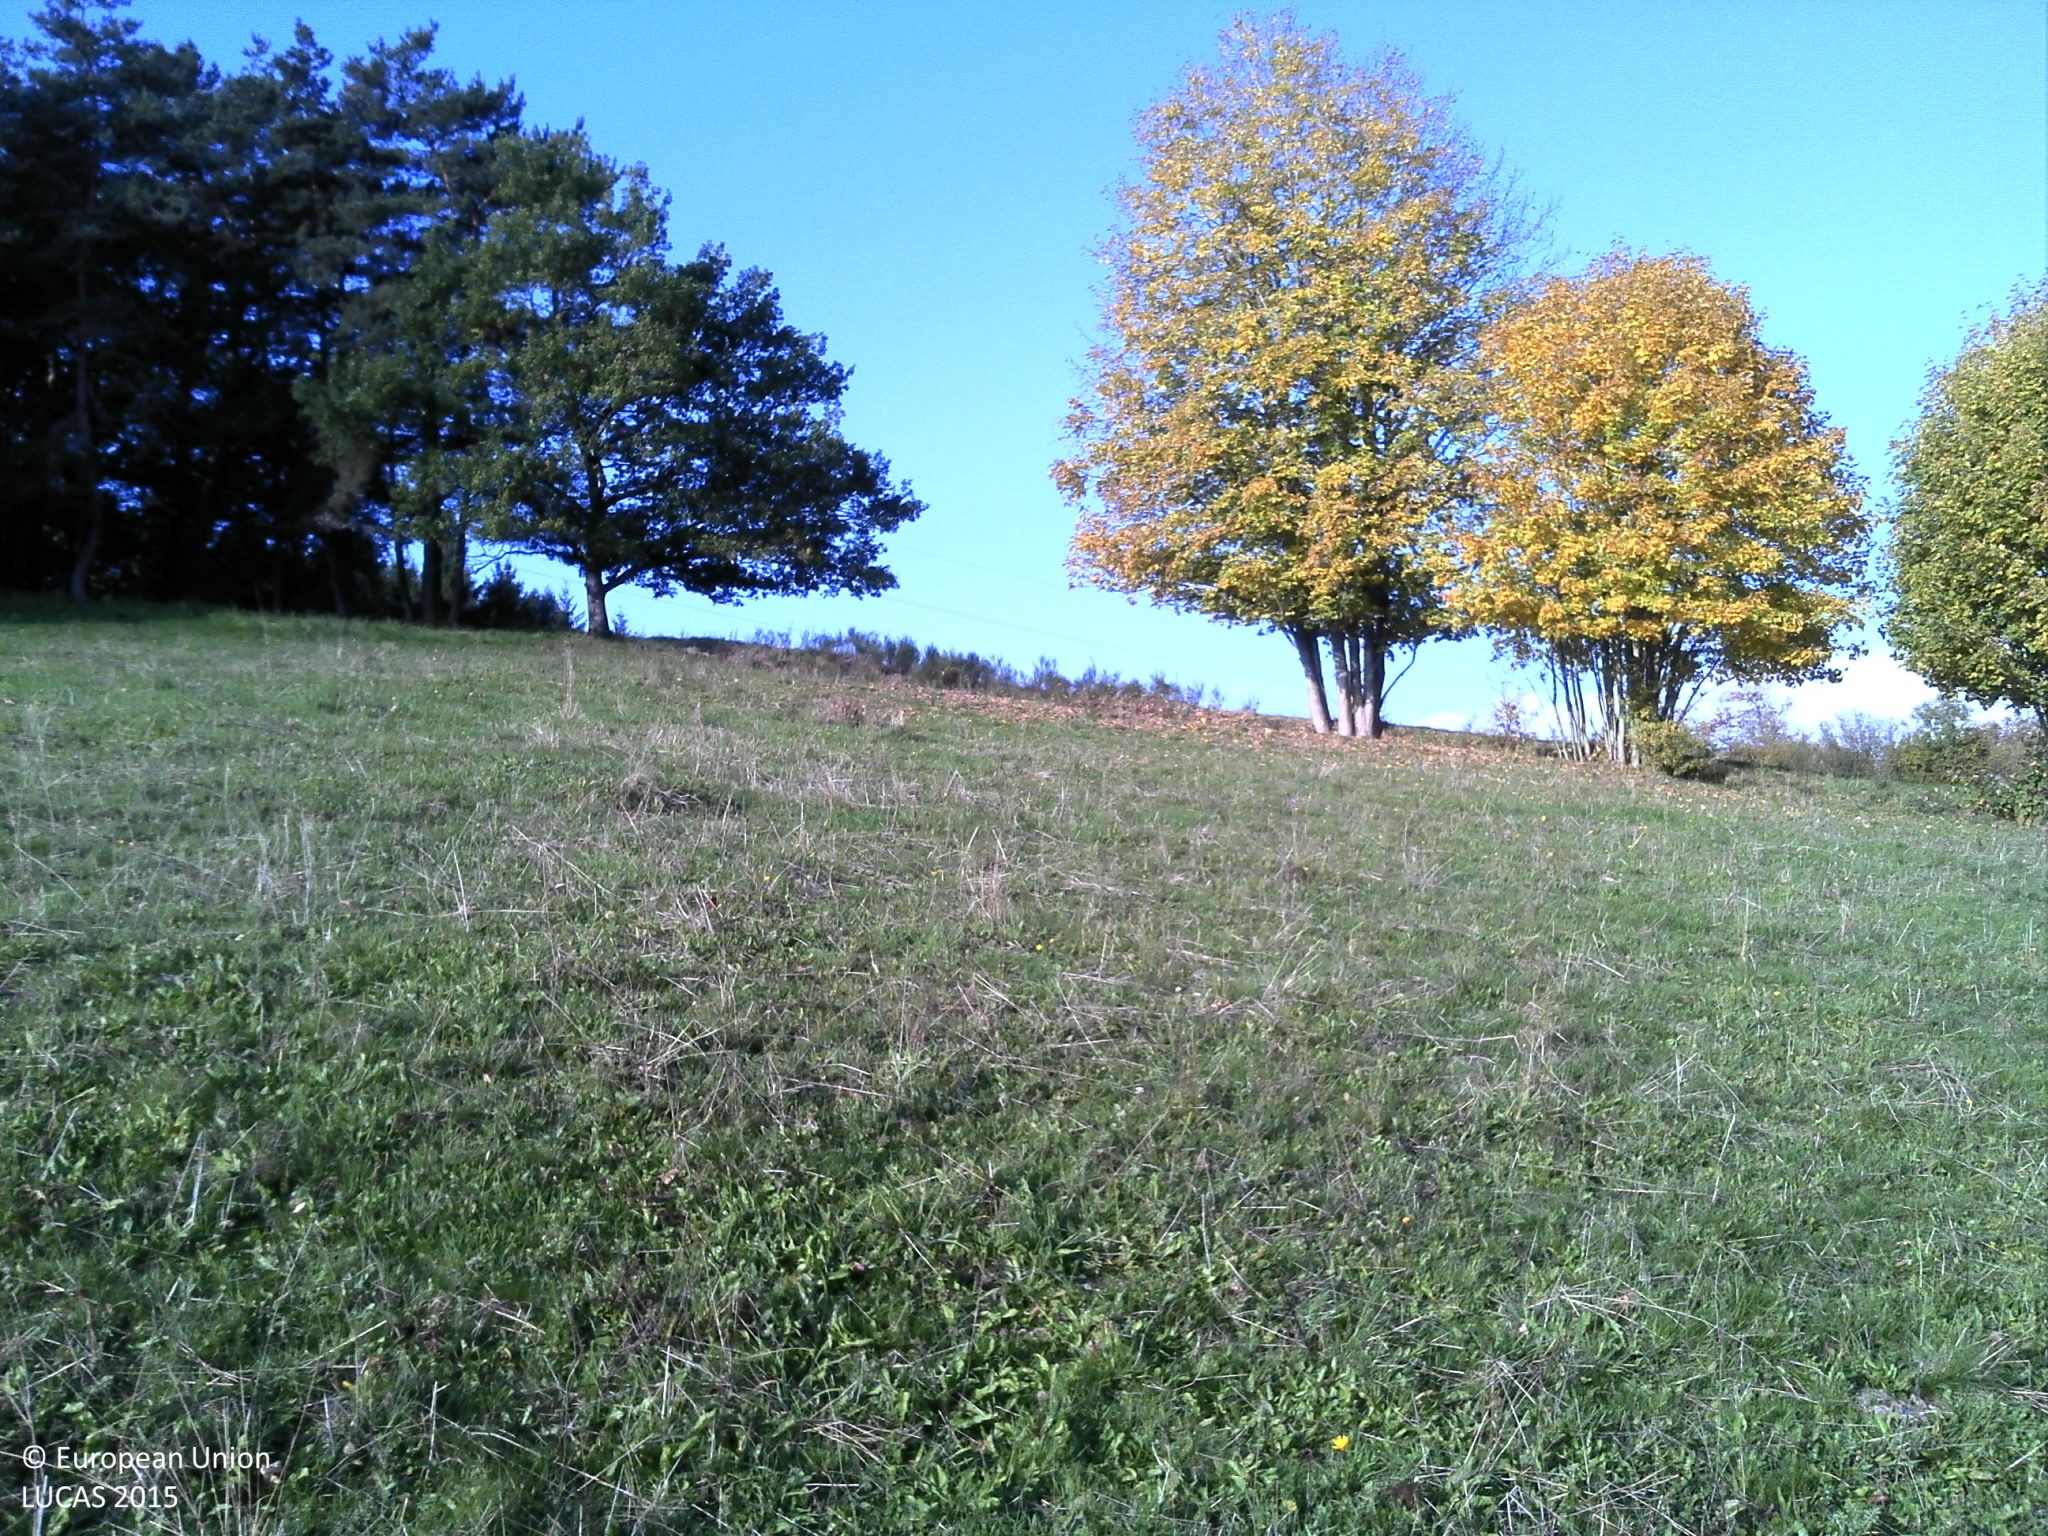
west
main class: Grassland
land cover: Grassland without tree/shrub cover
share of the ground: > 75 %
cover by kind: herbaceous plants 100 %
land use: Agriculture (excluding fallow land and kitchen gardens)
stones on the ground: < 10 %
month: October
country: FR
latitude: 45.5878
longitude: 3.7086
